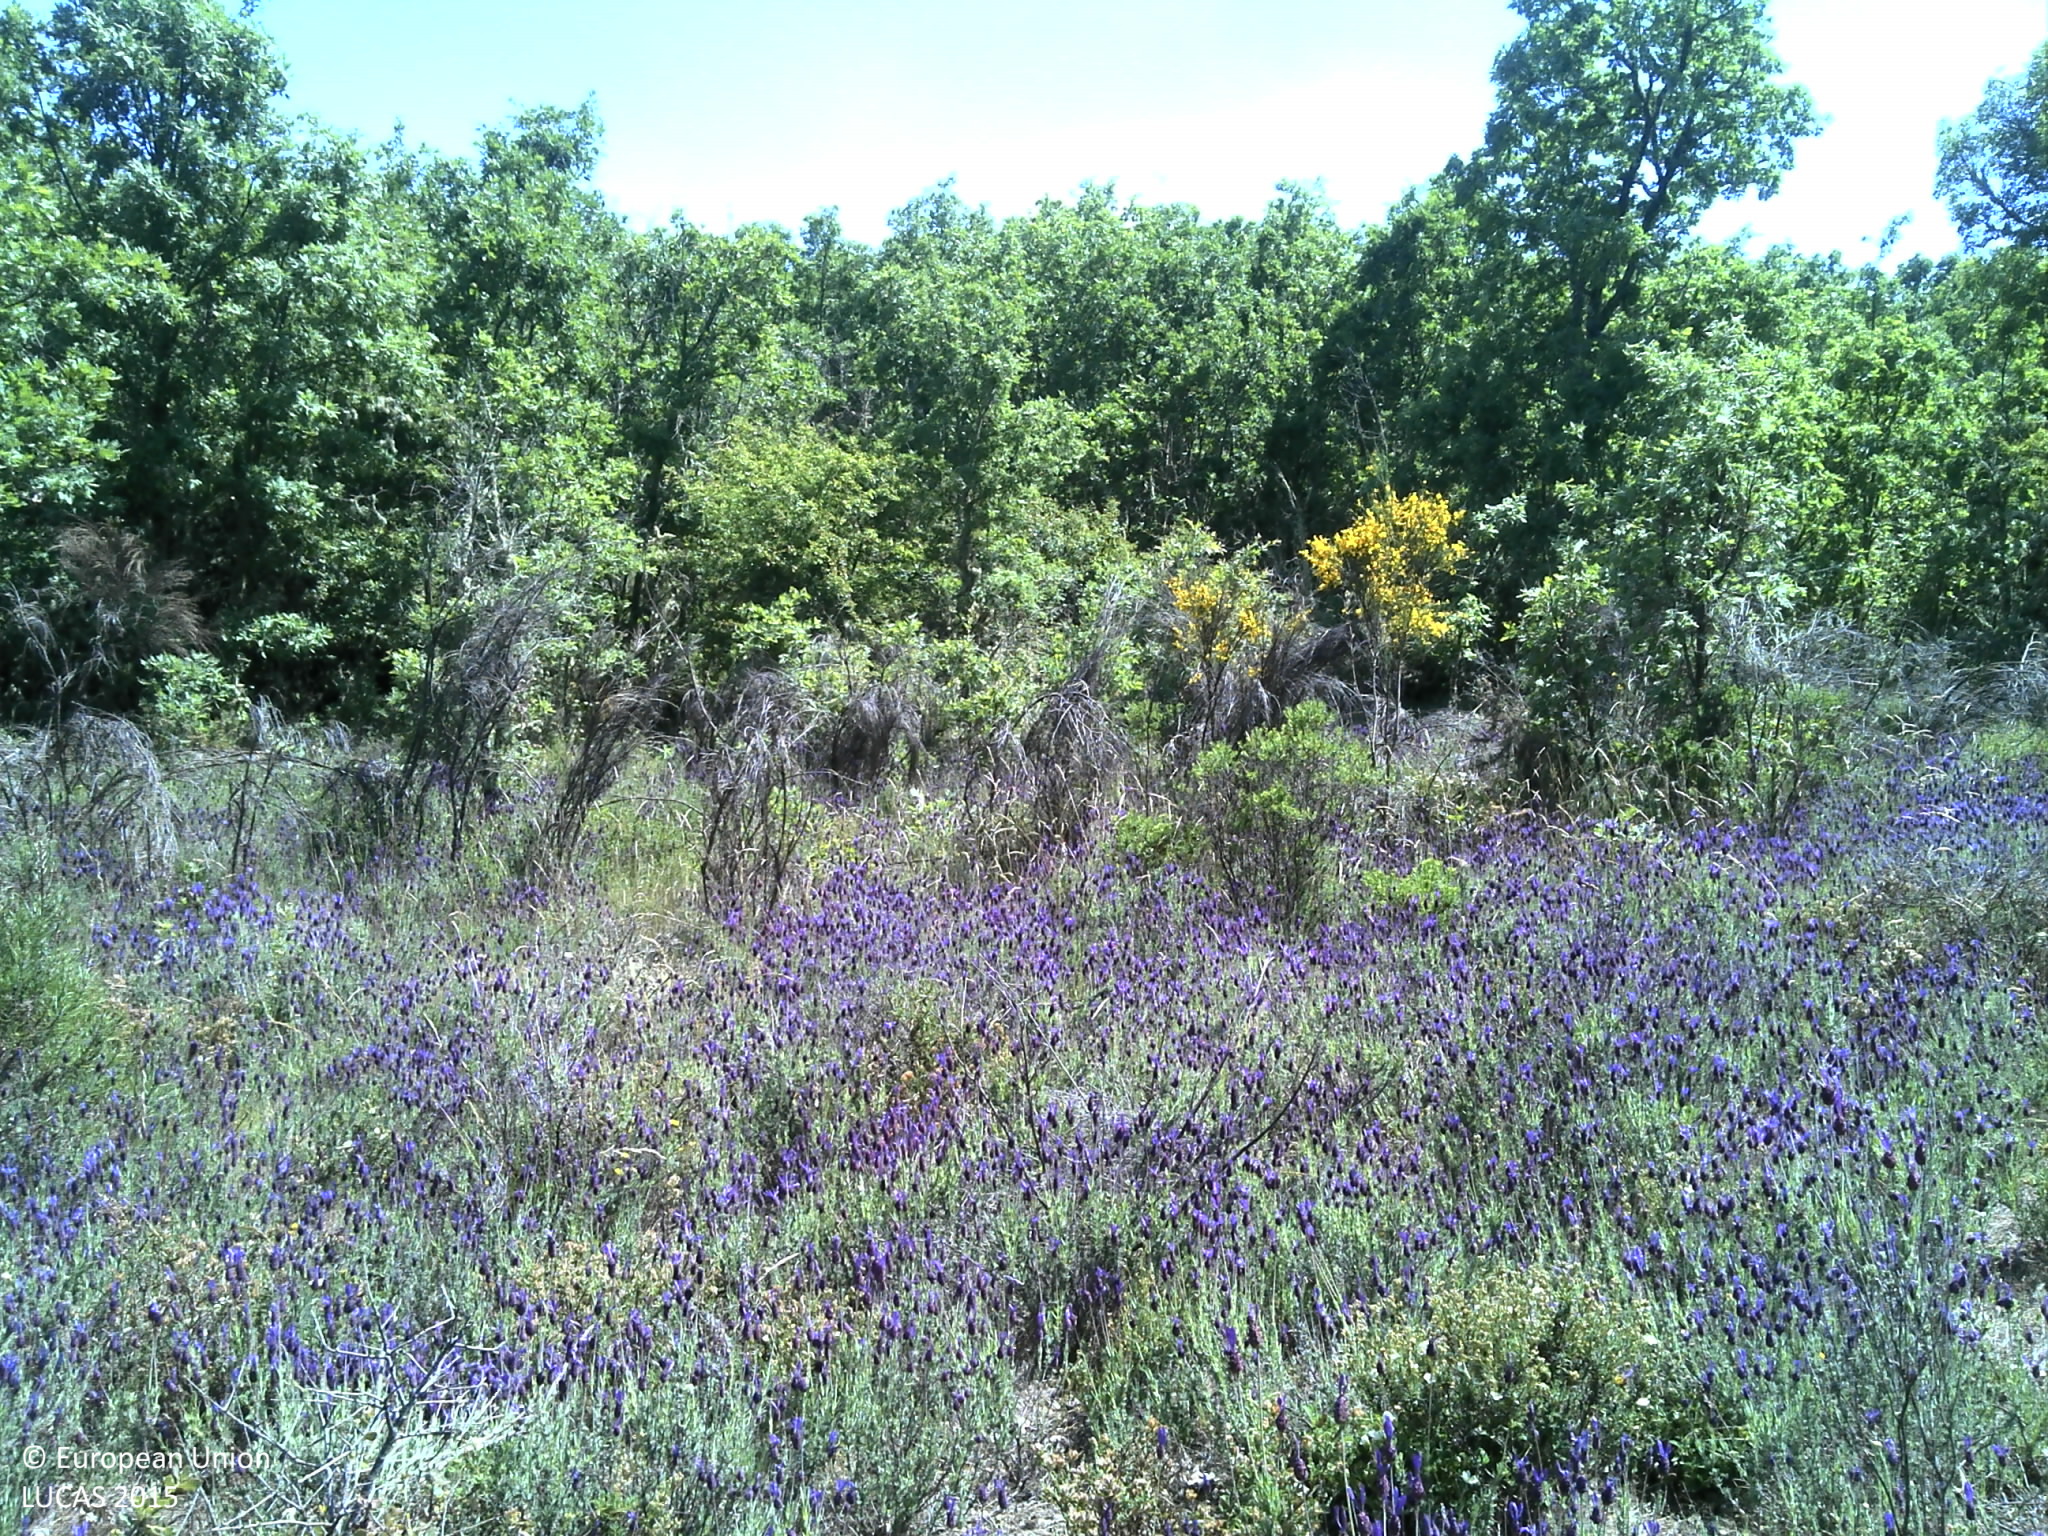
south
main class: Shrubland
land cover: Shrubland with sparse tree cover
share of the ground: > 75 %
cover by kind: shrubs 80 %, herbaceous plants 10 %, broadleaved forest trees 5 %, unconsolidated bare surface 5 %
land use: Forestry
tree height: > 5 m
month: May
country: PT
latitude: 41.5860
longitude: -6.3789
